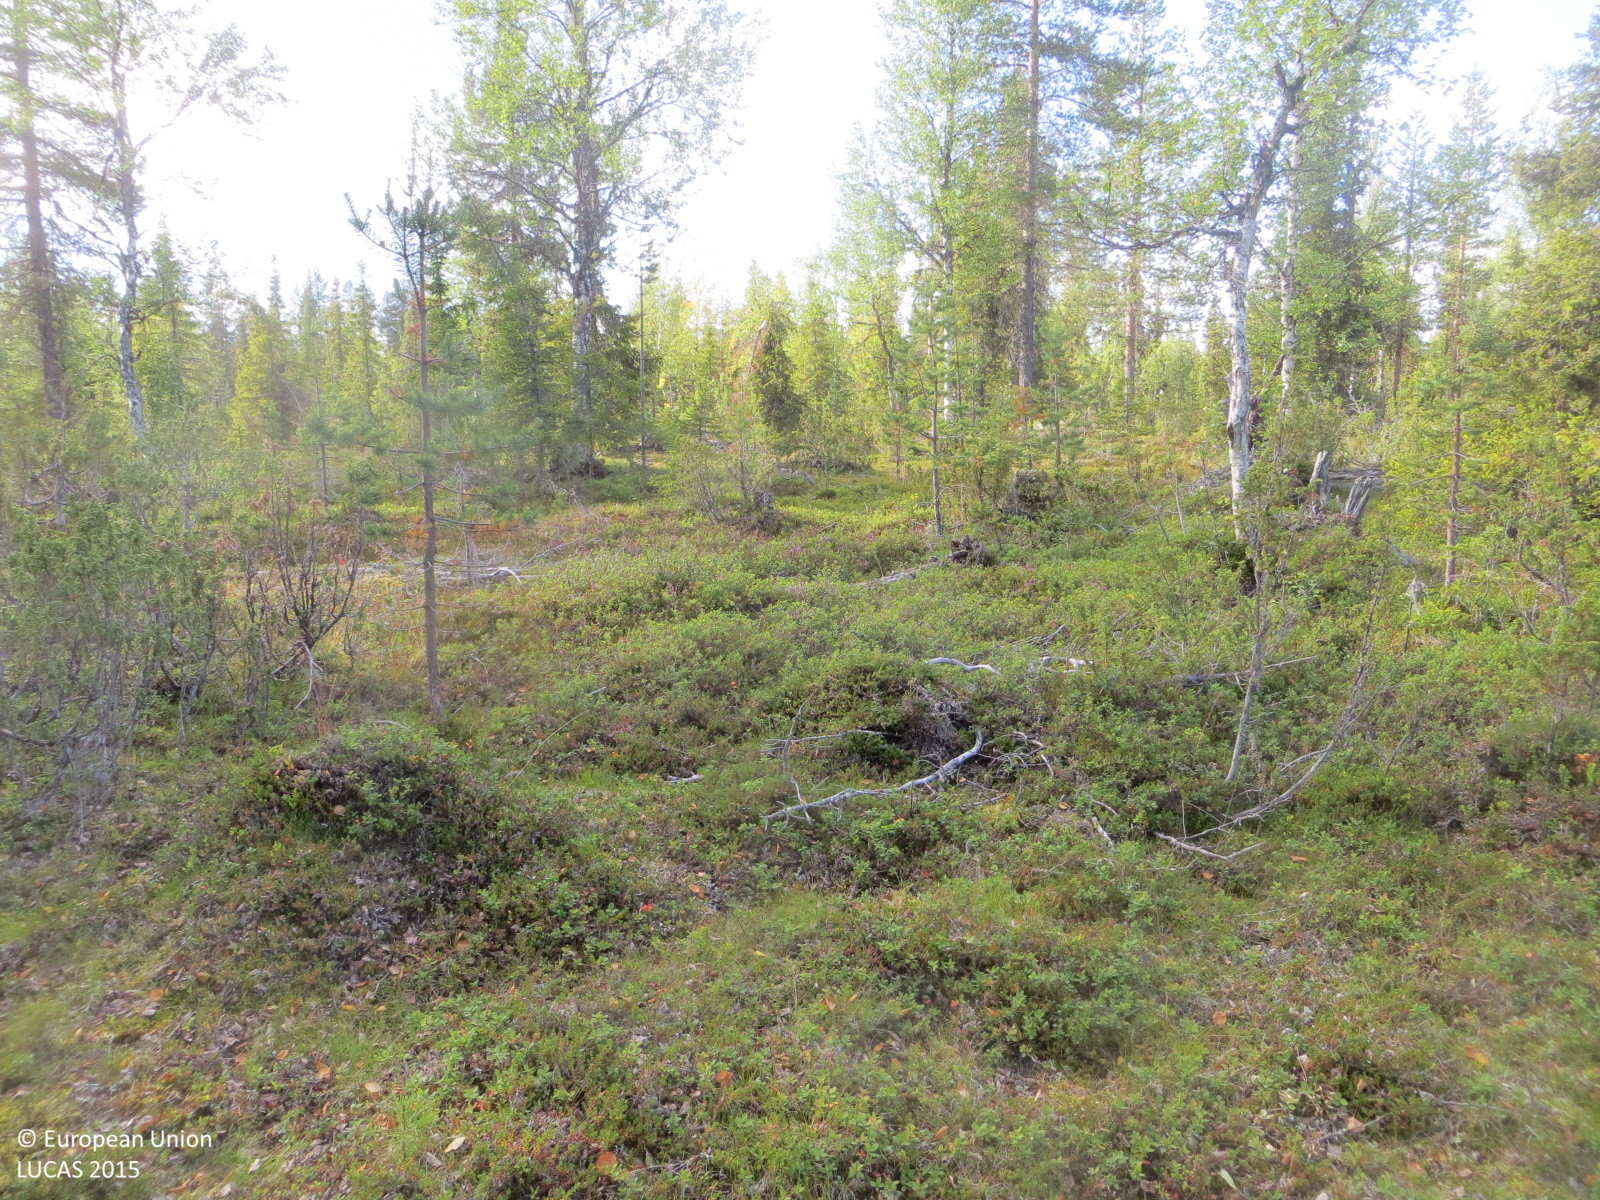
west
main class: Woodland
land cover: Other mixed woodland
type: hemiboreal forest and nemoral coniferous forest and mixed broadleaved-coniferous forest
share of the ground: 50 - 75 %
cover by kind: shrubs 50 %, coniferous forest trees 25 %, broadleaved forest trees 25 %
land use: Forestry
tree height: > 5 m
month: August
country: FI
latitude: 68.0461
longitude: 25.6469
